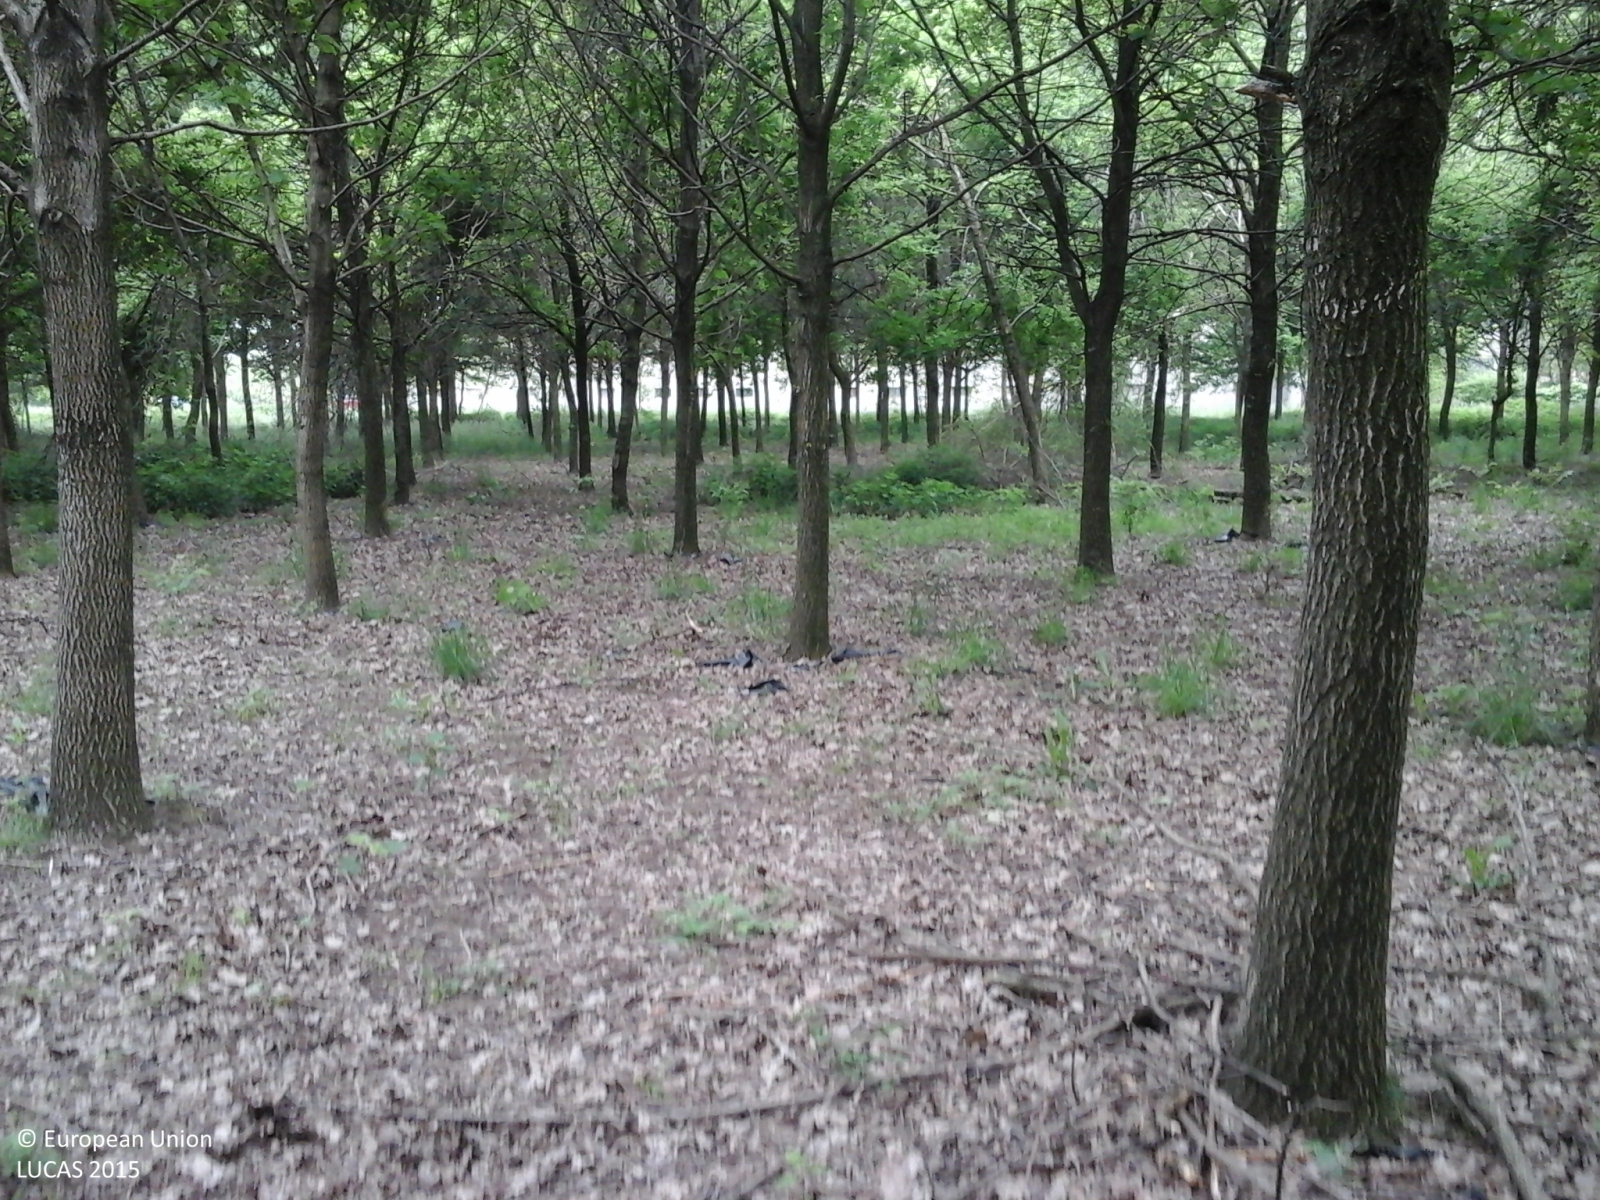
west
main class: Woodland
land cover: Broadleaved woodland
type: mesophytic deciduous forest
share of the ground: > 75 %
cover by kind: broadleaved forest trees 100 %
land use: Forestry
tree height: > 5 m
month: May
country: IT
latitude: 45.1259
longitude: 10.0634
